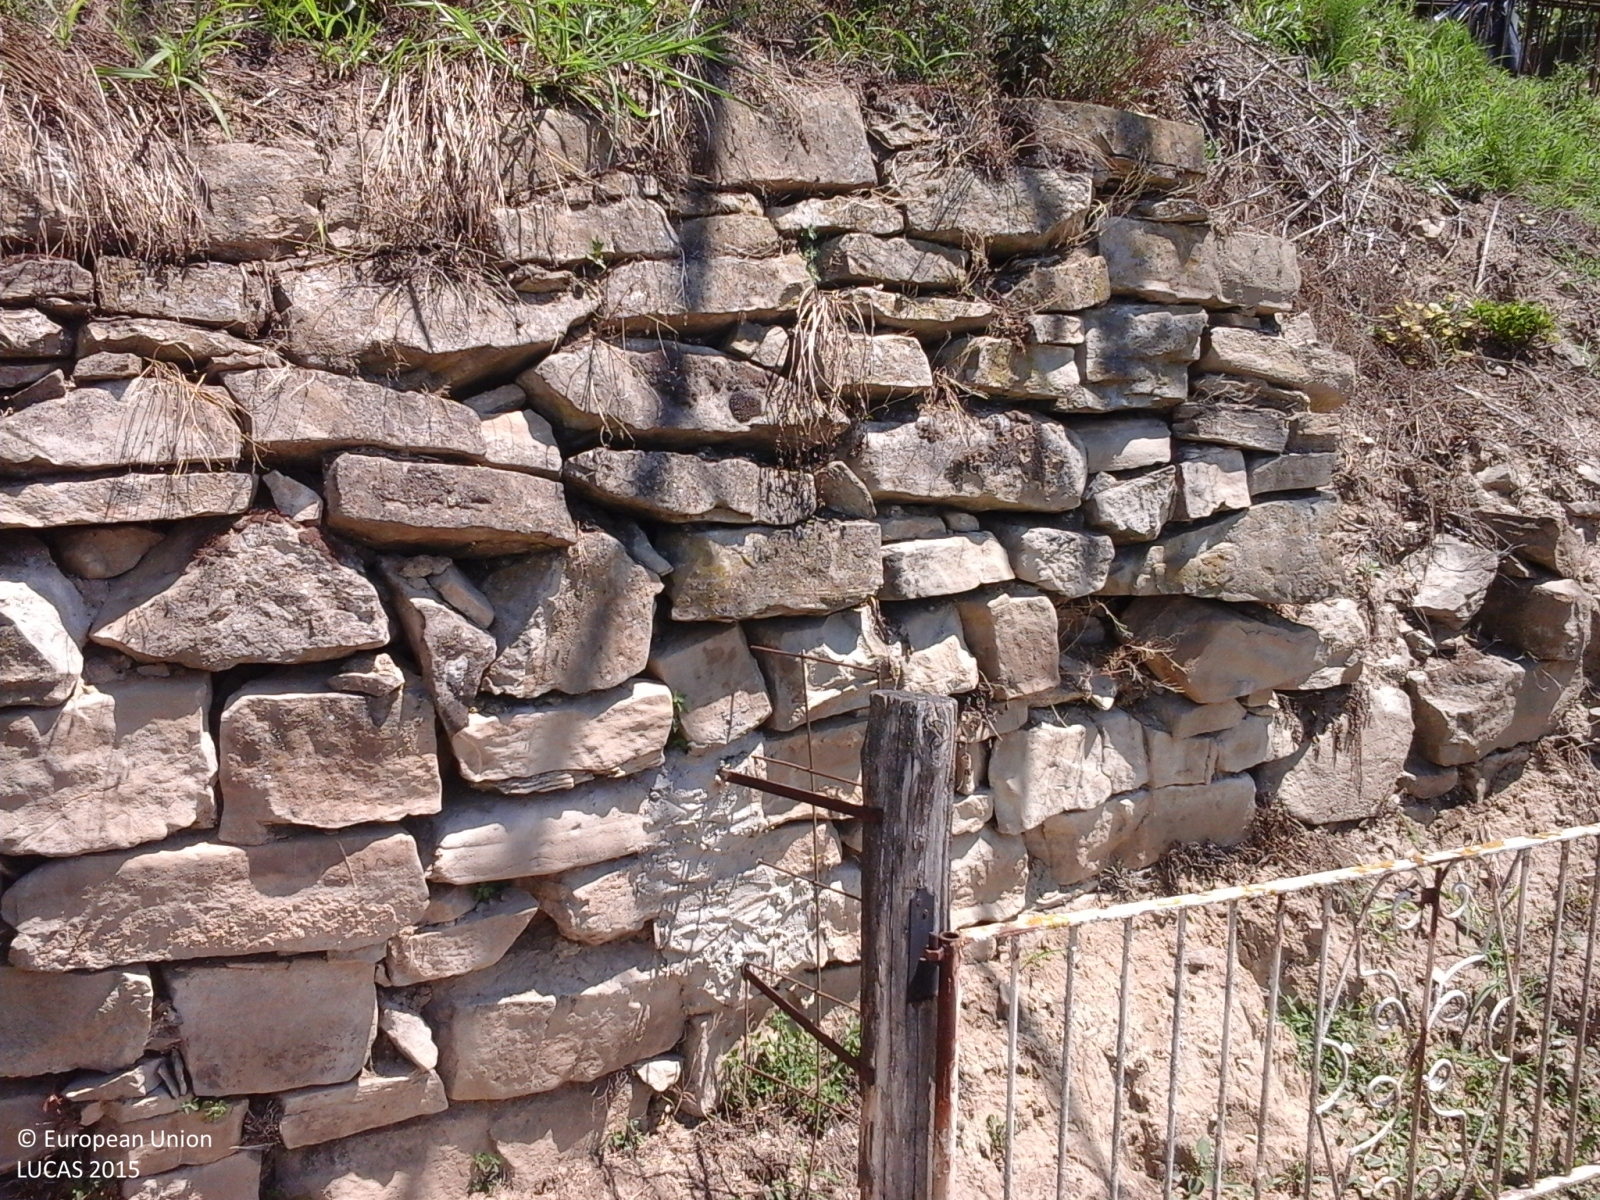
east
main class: Artificial land
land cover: Non built-up linear features
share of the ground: > 75 %
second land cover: Grassland without tree/shrub cover
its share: 10 - 25 %
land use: Road transport
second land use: Agriculture (excluding fallow land and kitchen gardens)
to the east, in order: Artificial constructions in urban areas; Grassland without tree/shrub cover; Single bushes/trees; Grassland without tree/shrub cover; Tracks; Grassland without tree/shrub cover; Electric lines; Grassland without tree/shrub cover; Broadleaved woodland; Dry stone walls; Grassland without tree/shrub cover; Dry stone walls; Shrubland with sparse tree cover; Broadleaved woodland; Paved roads, cycling and walking lanes; Dry stone walls; Tracks; Grassland with sparse tree/shrub cover; Electric lines; Grassland with sparse tree/shrub cover; Nuts trees; Tracks; Dry stone walls; Broadleaved woodland; Dry stone walls; Broadleaved woodland; Dry stone walls; Shrubland with sparse tree cover; Broadleaved woodland
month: June
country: IT
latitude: 44.5691
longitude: 8.1780
